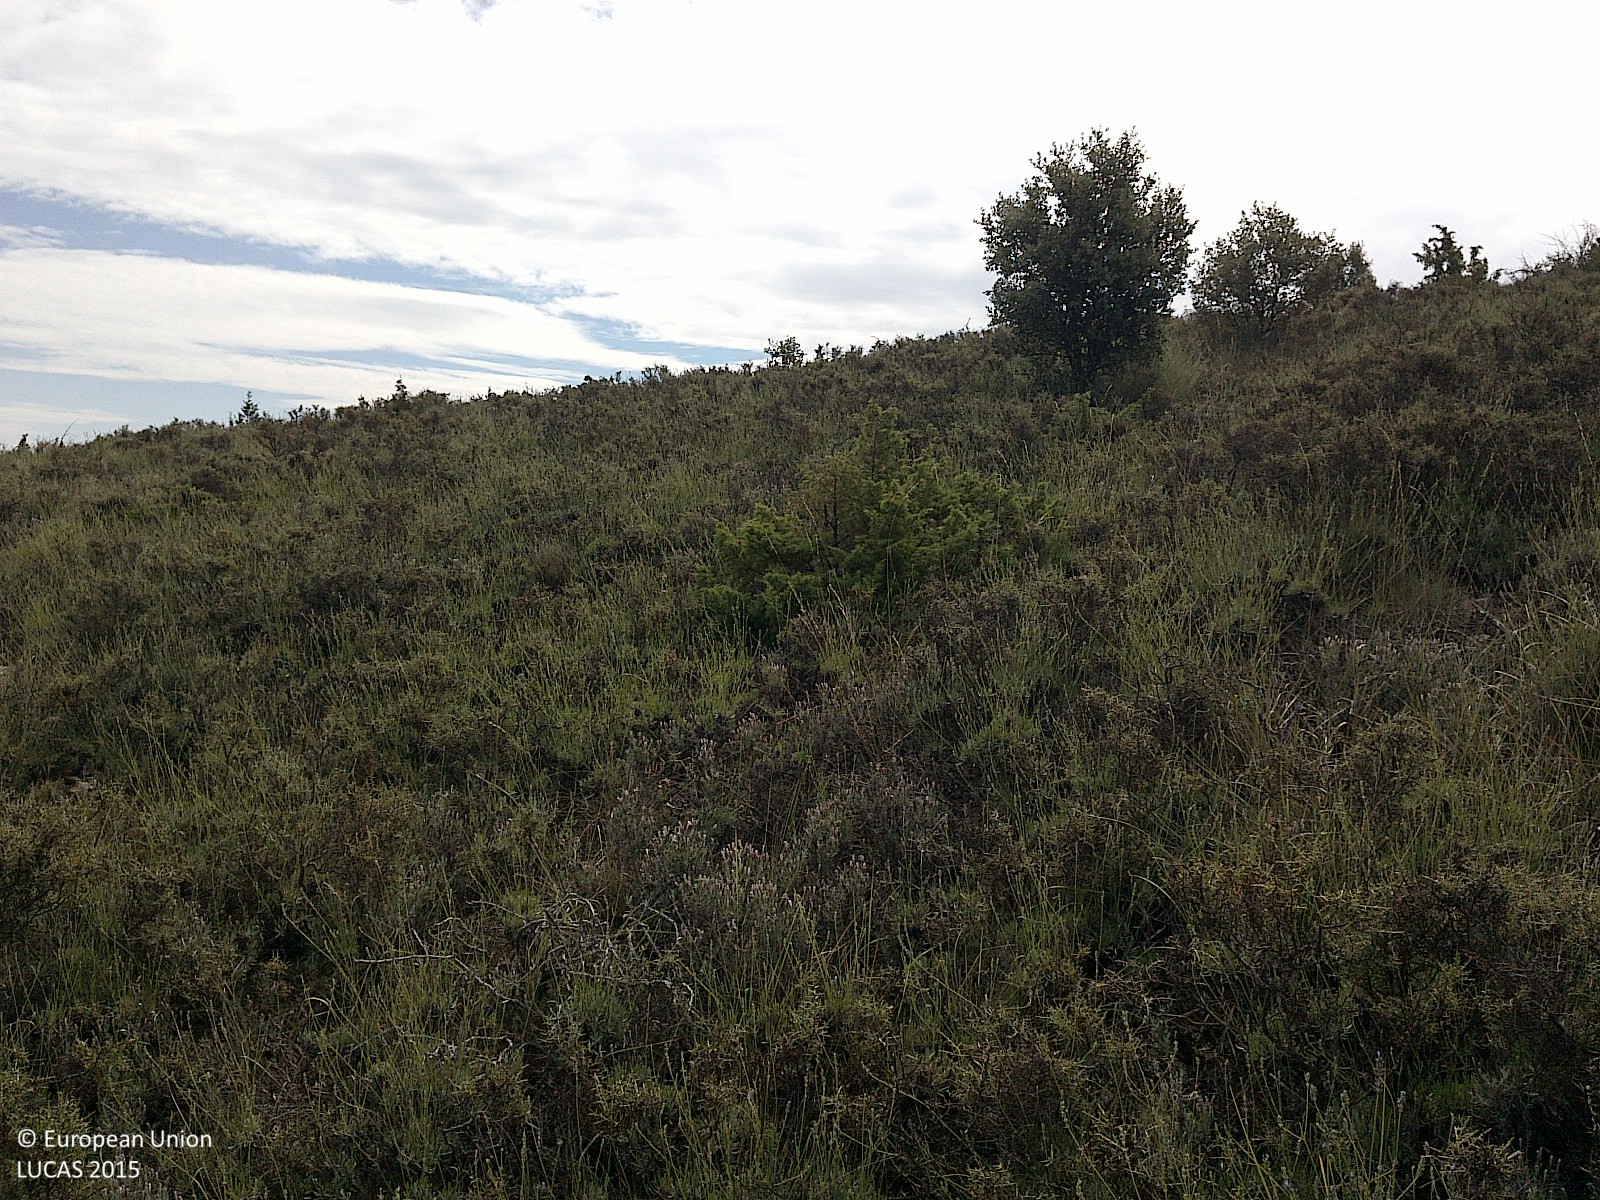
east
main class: Shrubland
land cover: Shrubland with sparse tree cover
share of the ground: > 75 %
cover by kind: shrubs 85 %, herbaceous plants 10 %, broadleaved forest trees 5 %
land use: Semi-natural and natural areas not in use
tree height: < 5 m
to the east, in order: Shrubland with sparse tree cover; Shrubland without tree cover
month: July
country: ES
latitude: 41.5416
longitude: -1.9574
